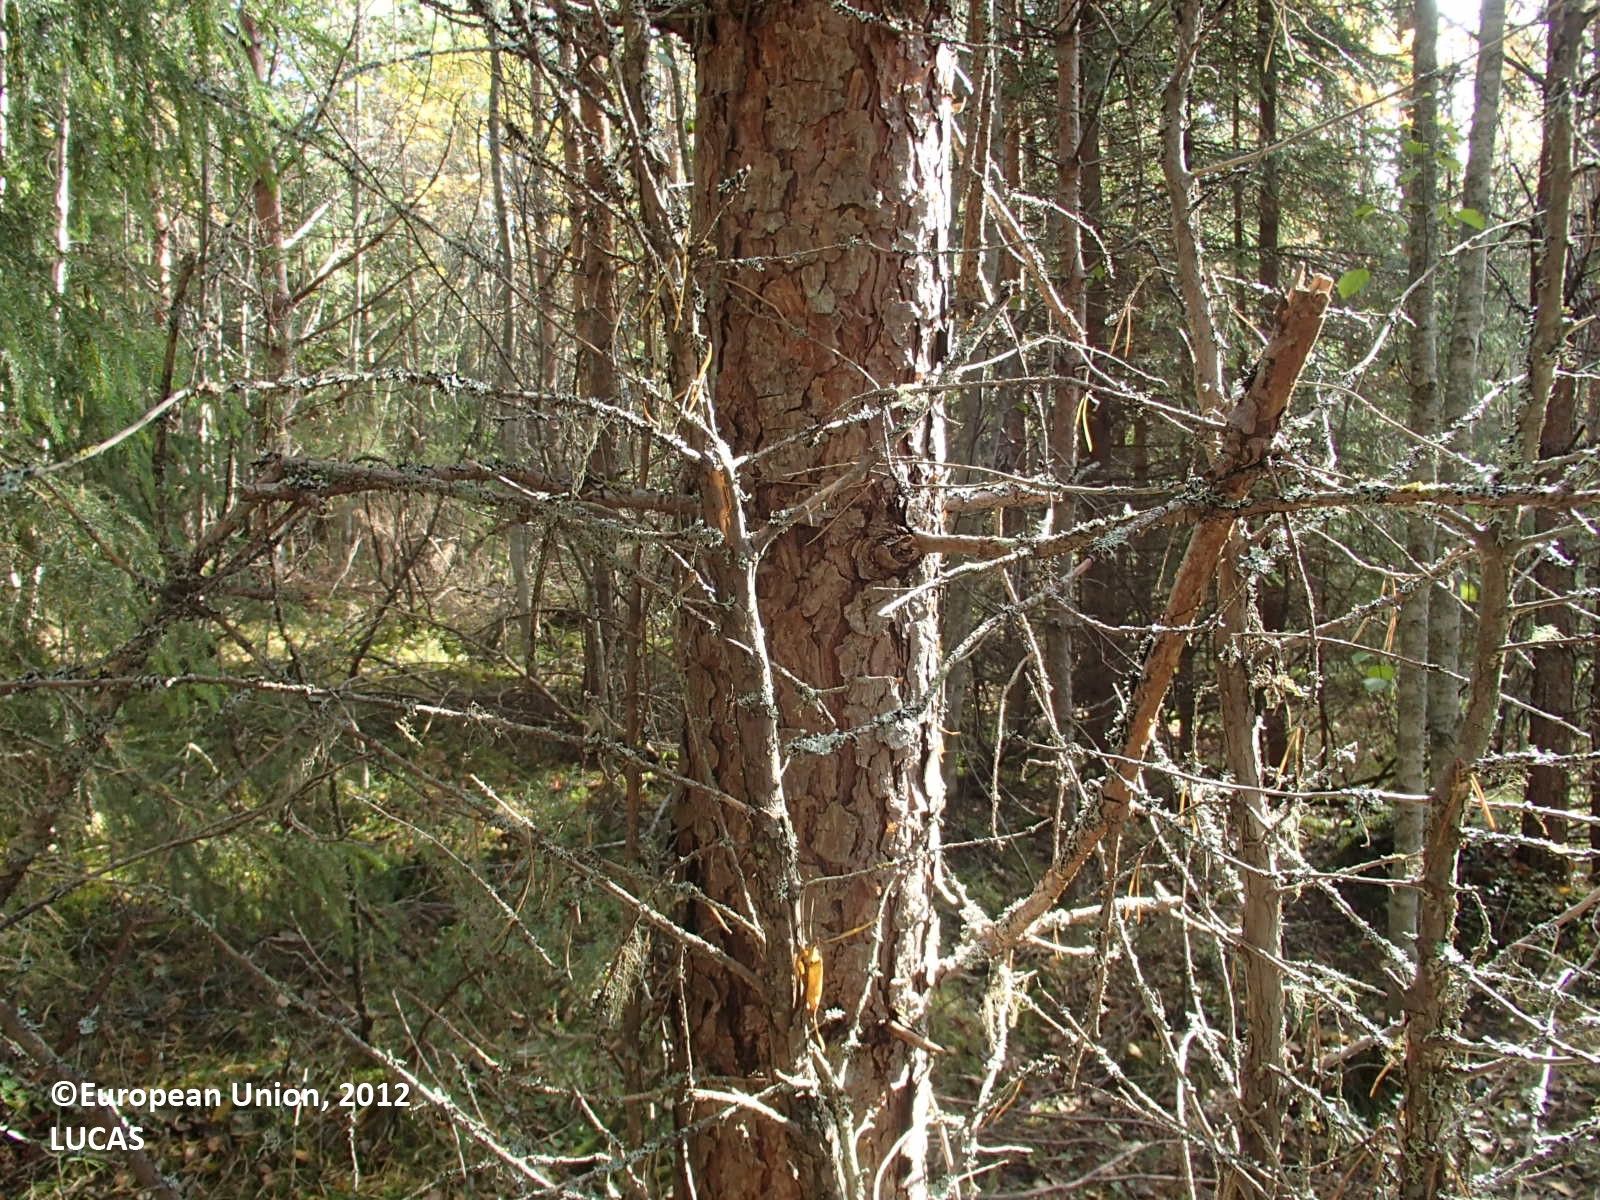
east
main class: Woodland
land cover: Pine dominated mixed woodland
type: boreal forest
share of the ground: > 75 %
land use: Forestry
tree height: > 5 m
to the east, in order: Pine dominated mixed woodland
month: September
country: FI
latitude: 63.3968
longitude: 27.8005
